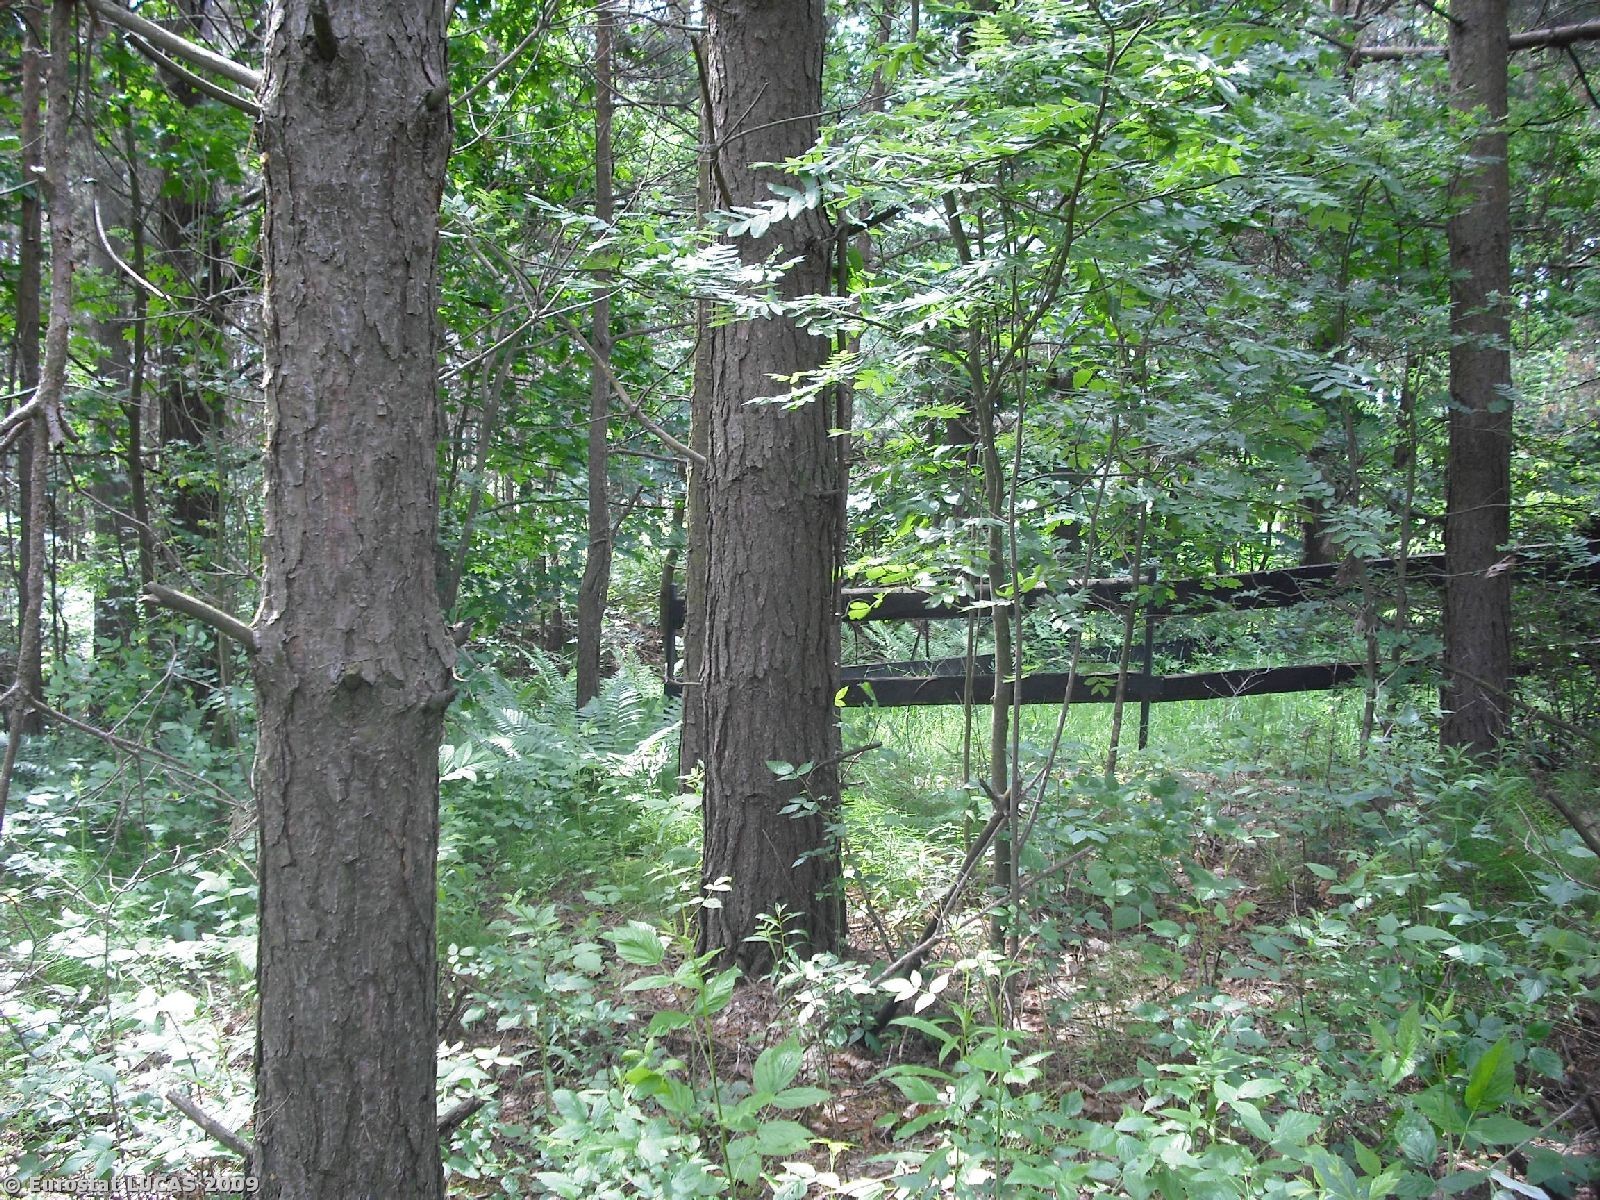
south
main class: Woodland
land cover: Coniferous woodland
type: hemiboreal forest and nemoral coniferous forest and mixed broadleaved-coniferous forest
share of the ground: > 75 %
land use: Forestry
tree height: > 5 m
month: June
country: PL
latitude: 54.2614
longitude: 22.8587
